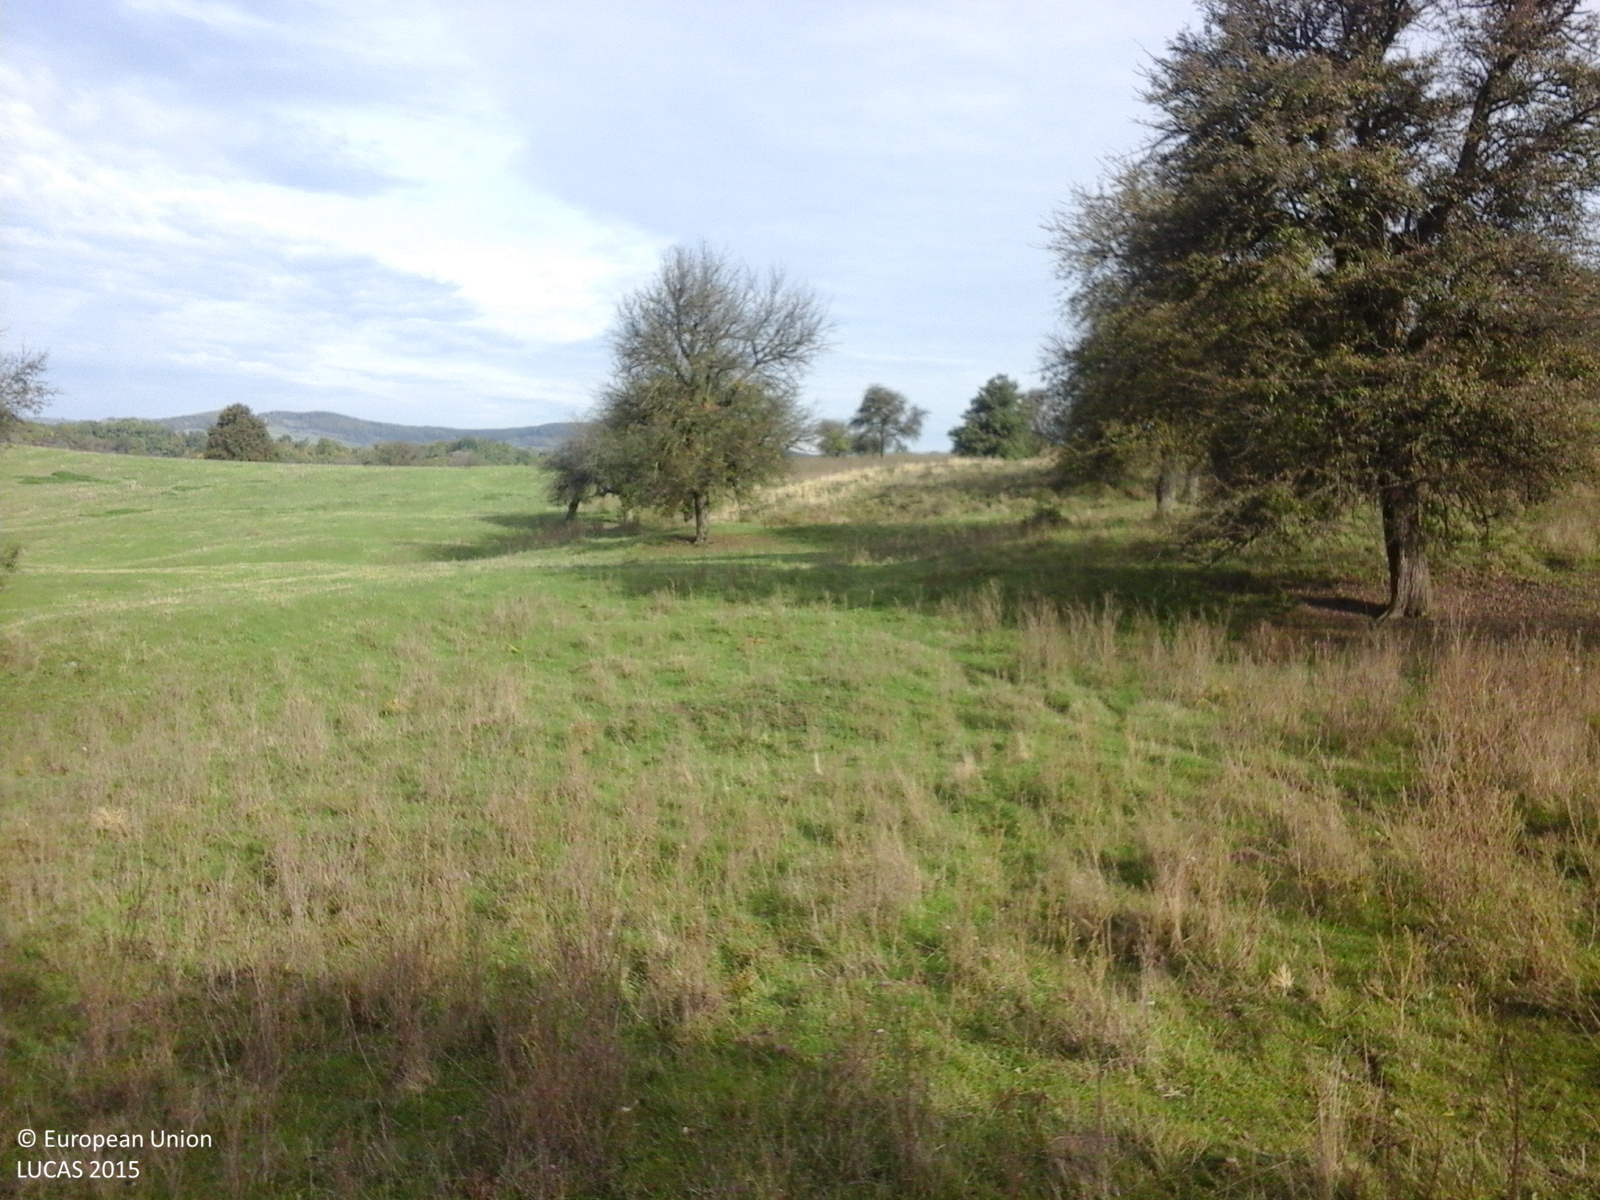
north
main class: Cropland
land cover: Pear fruit
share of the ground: > 75 %
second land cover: Grassland without tree/shrub cover
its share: > 75 %
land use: Agriculture (excluding fallow land and kitchen gardens)
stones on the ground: < 10 %
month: October
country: RO
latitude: 46.1779
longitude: 25.1642
